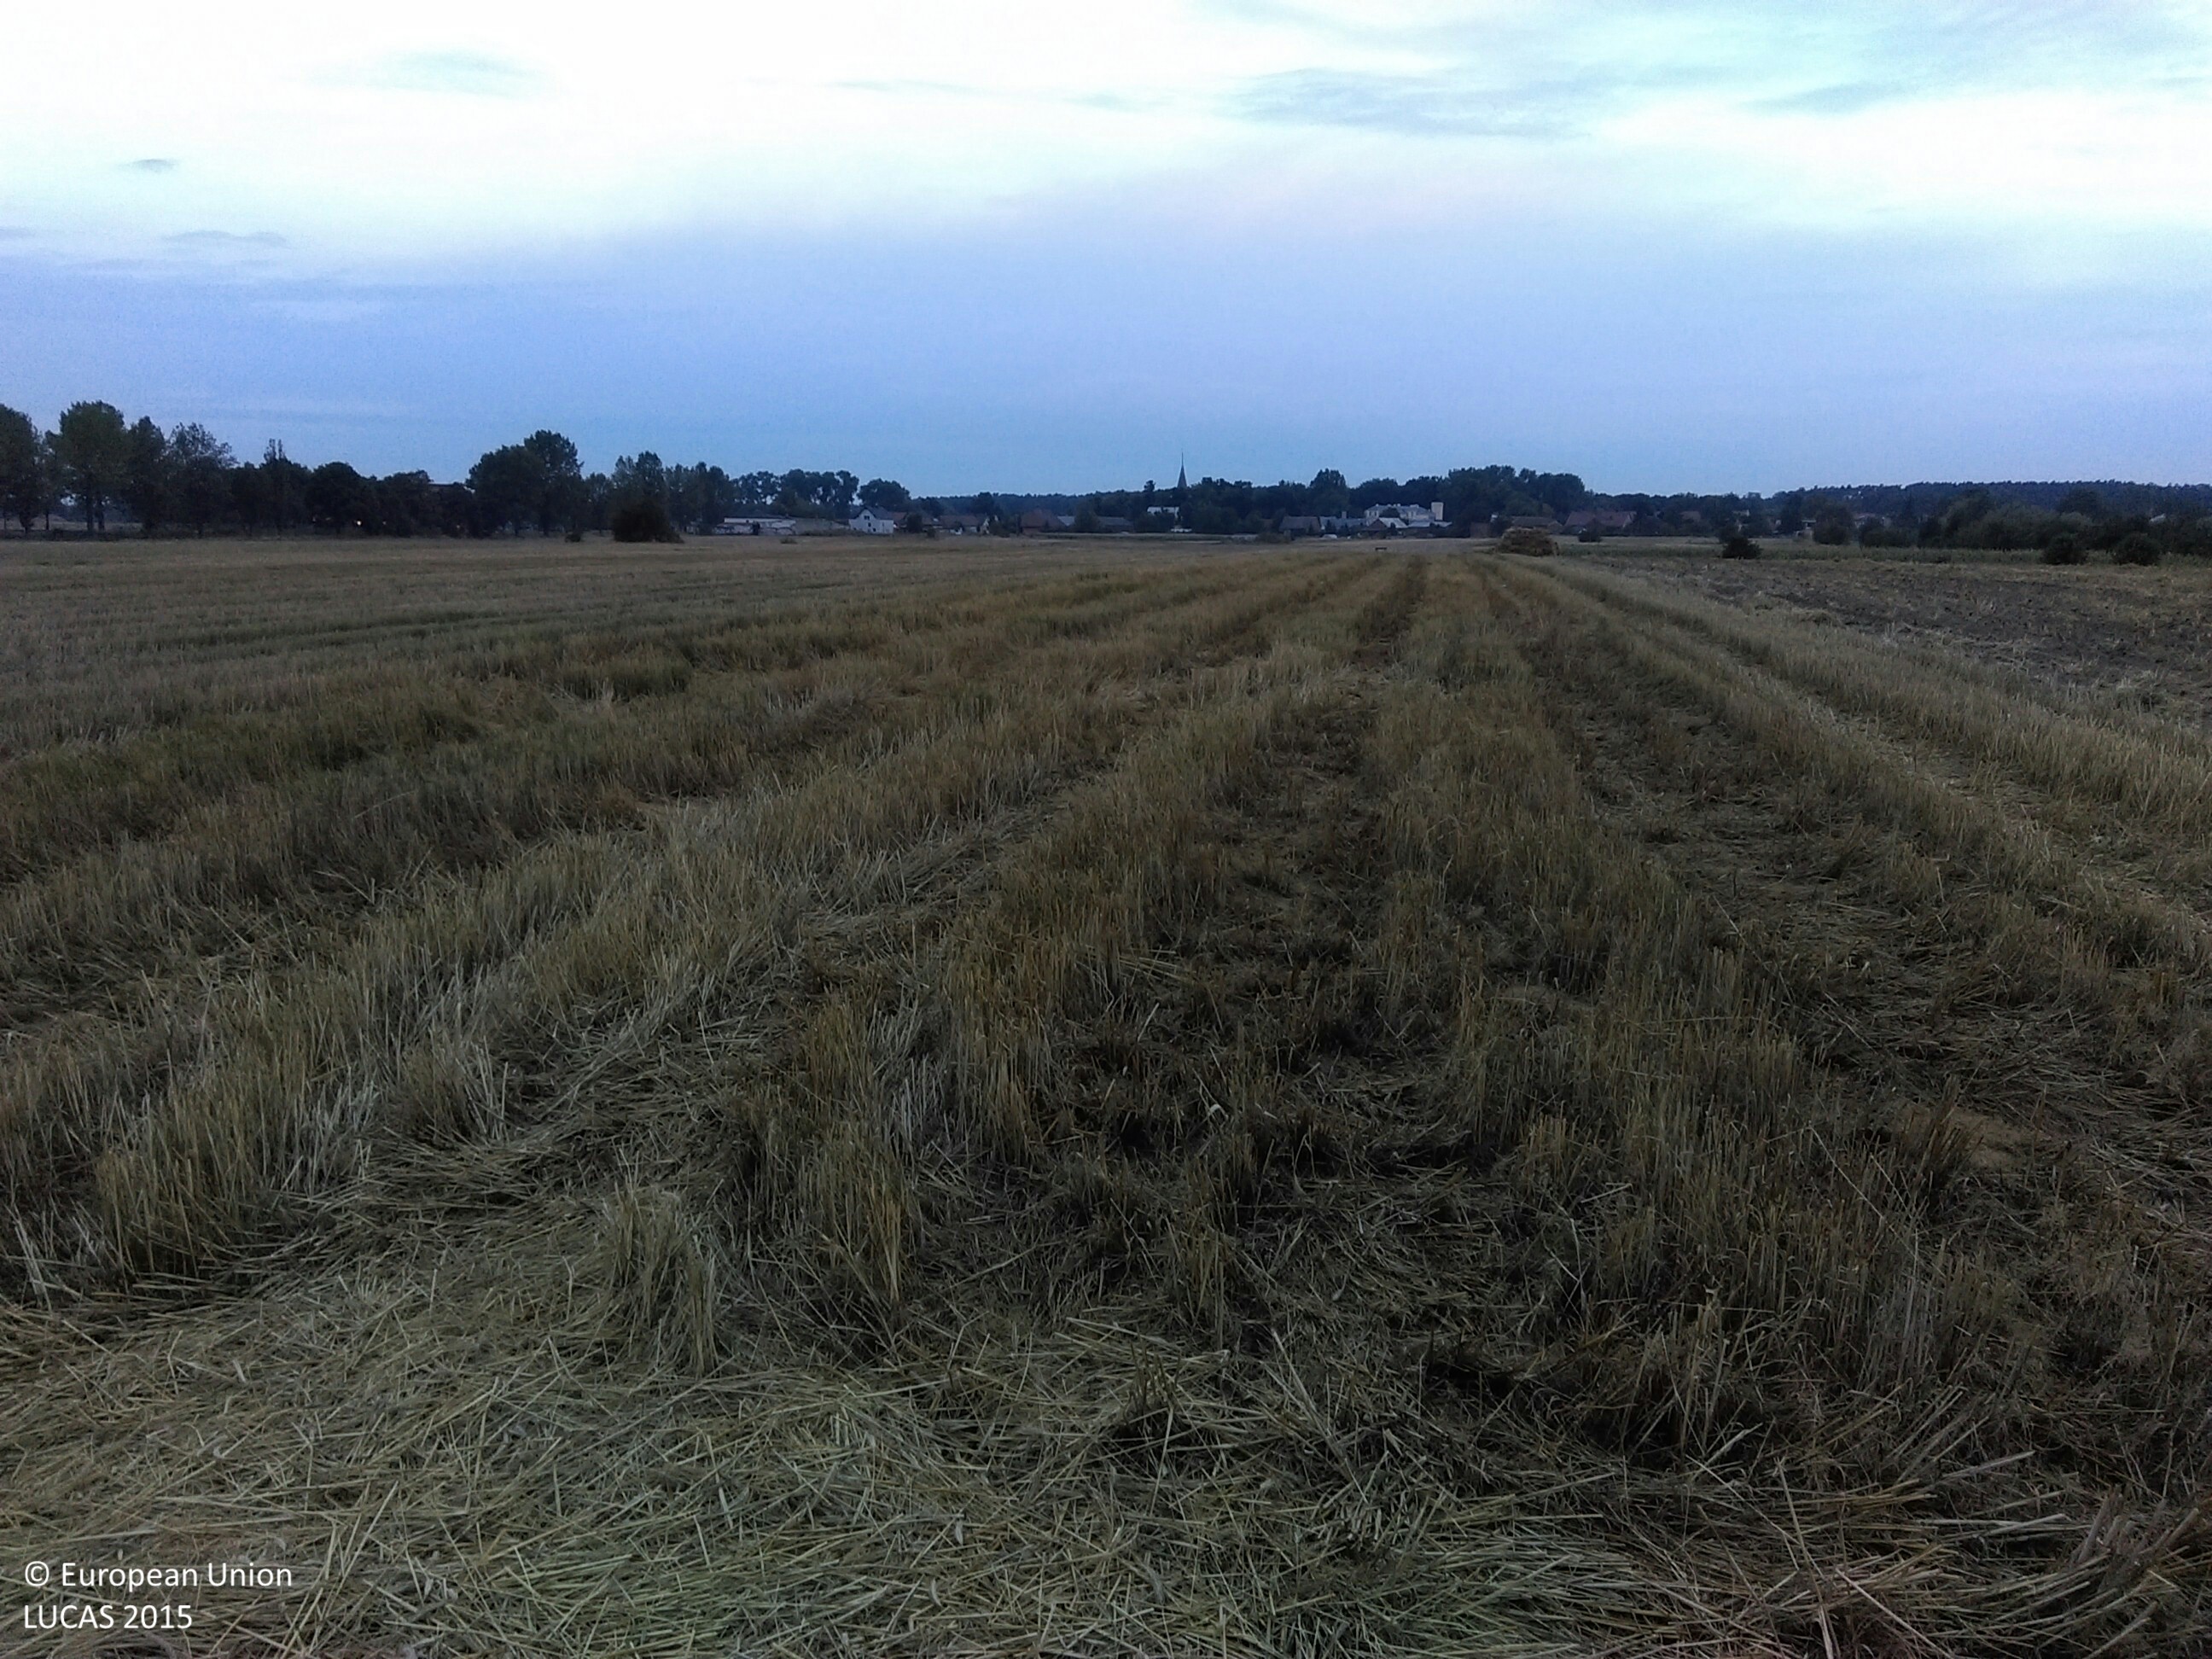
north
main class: Cropland
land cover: Rye
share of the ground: > 75 %
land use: Agriculture (excluding fallow land and kitchen gardens)
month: August
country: PL
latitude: 52.1193
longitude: 15.5980
